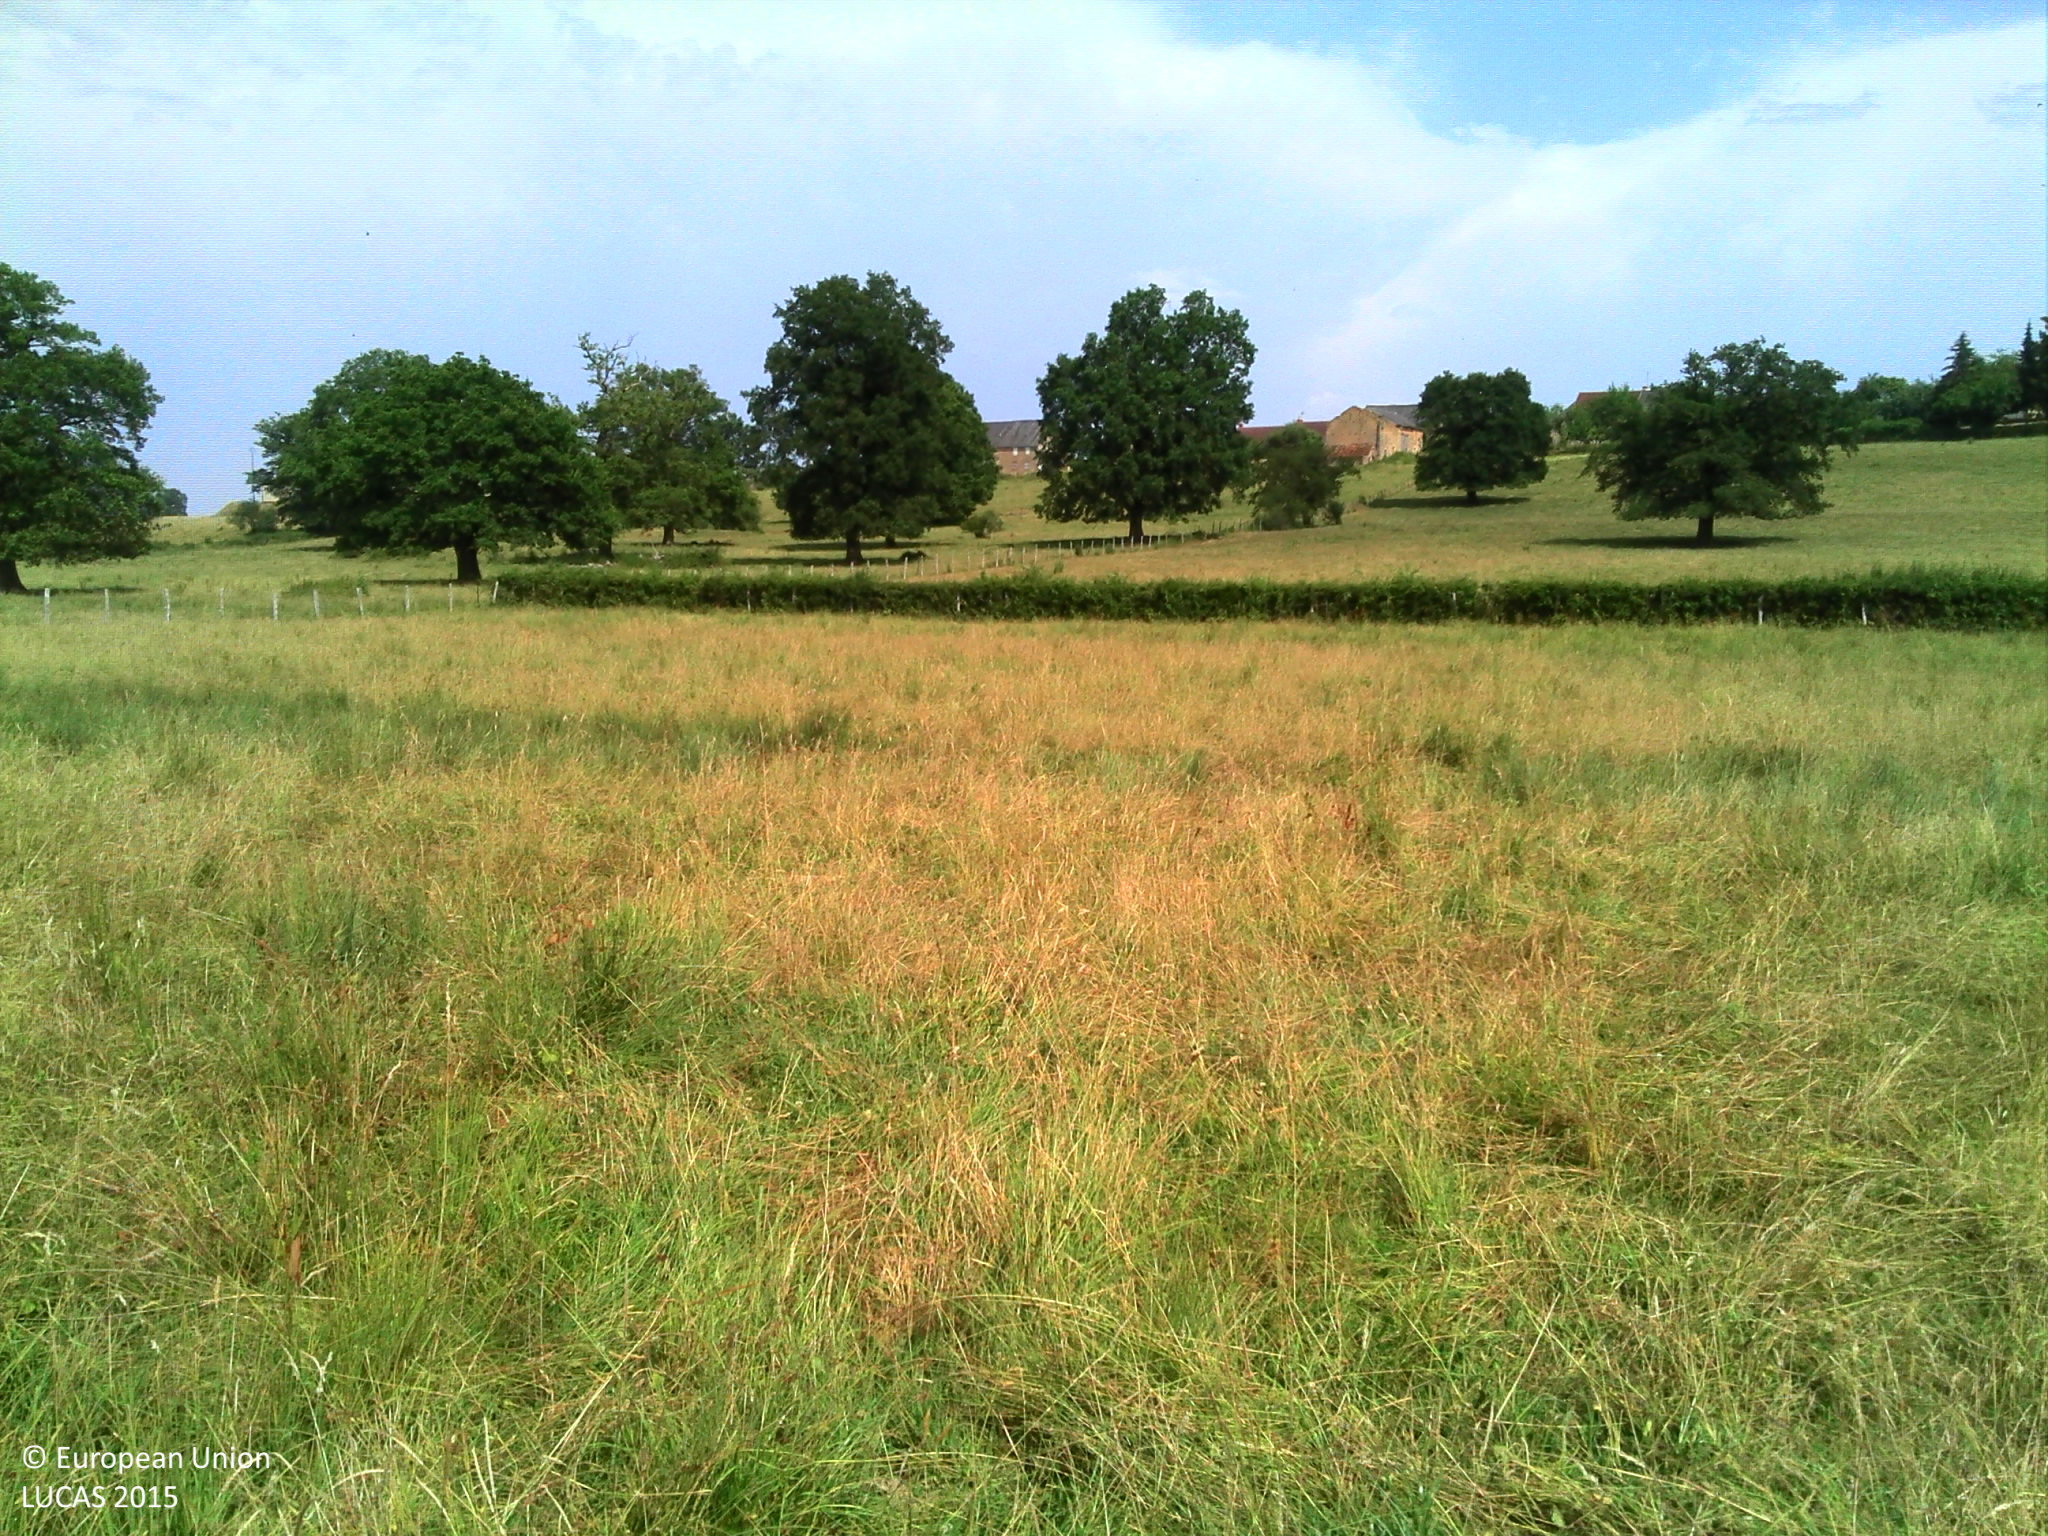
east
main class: Grassland
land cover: Grassland without tree/shrub cover
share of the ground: > 75 %
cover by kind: herbaceous plants 100 %
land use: Agriculture (excluding fallow land and kitchen gardens)
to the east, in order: Grassland without tree/shrub cover; Fences; Managed hedges; Grassland without tree/shrub cover; Fences; Grassland with sparse tree/shrub cover
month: July
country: FR
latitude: 47.2215
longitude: 3.5394
